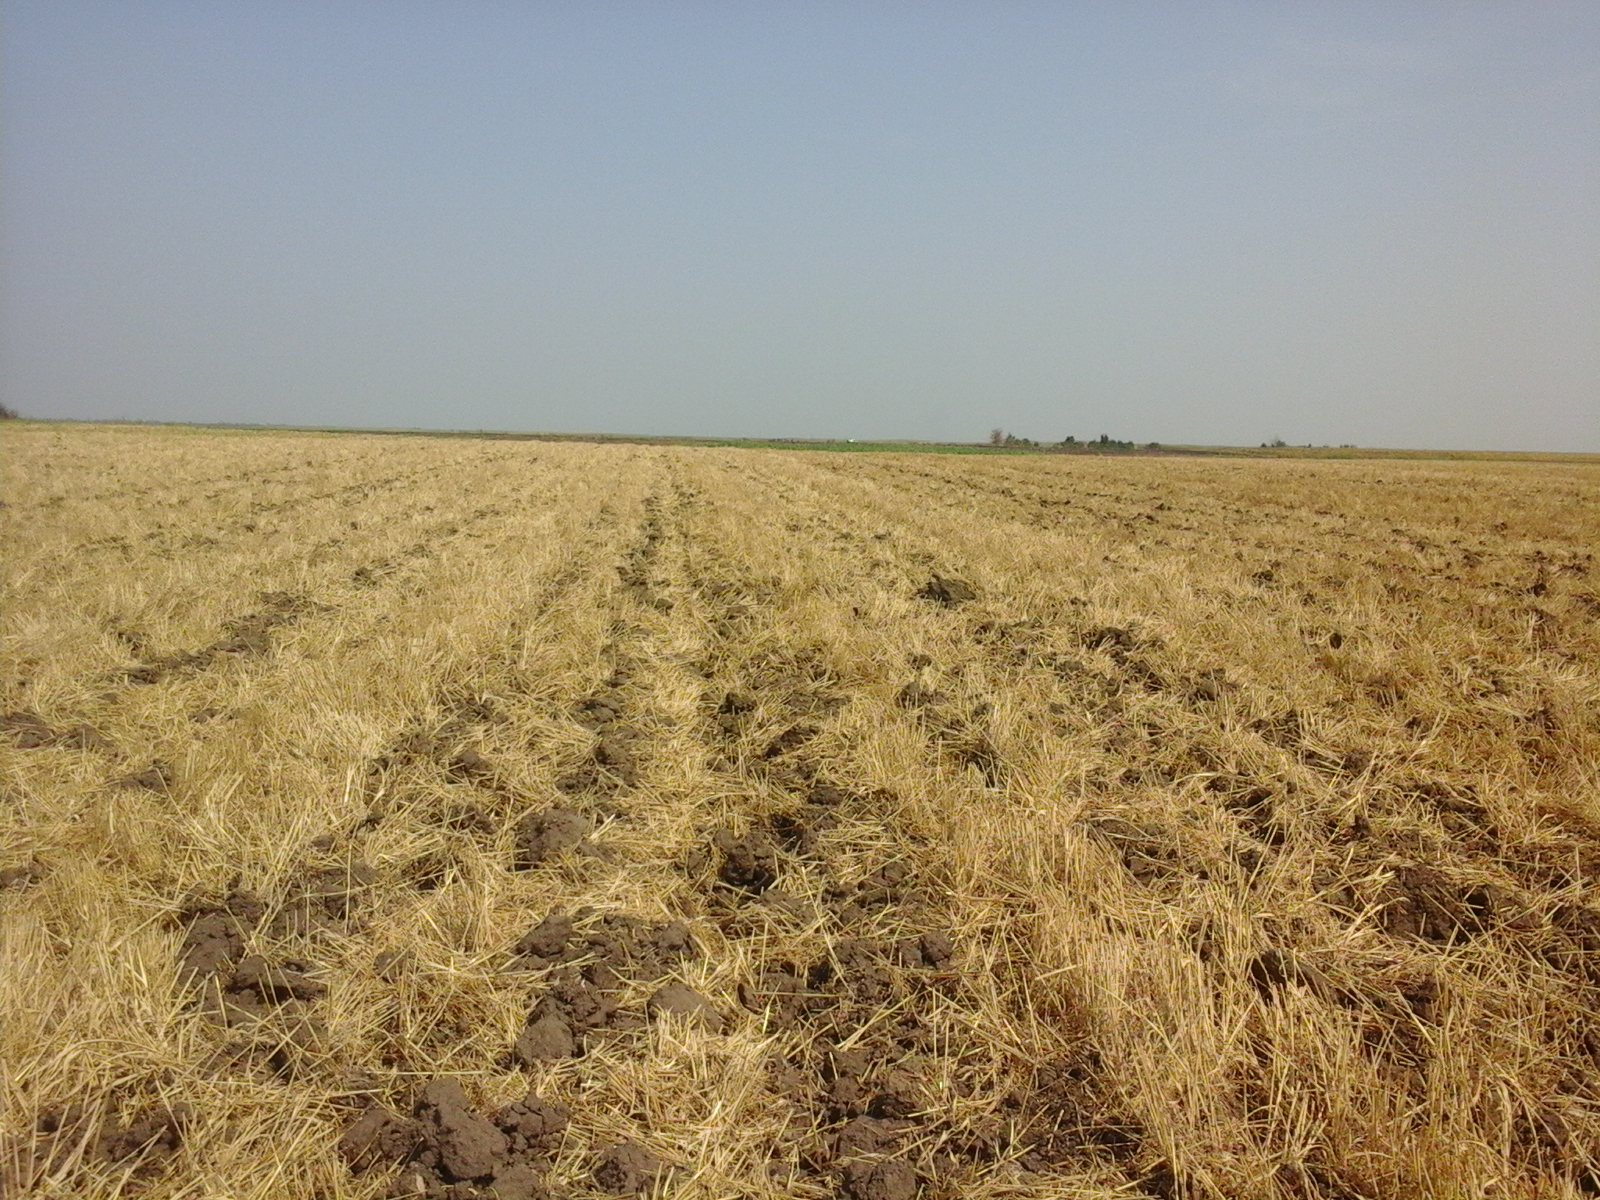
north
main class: Cropland
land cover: Common wheat
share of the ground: 50 - 75 %
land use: Agriculture (excluding fallow land and kitchen gardens)
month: August
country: RO
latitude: 43.9060
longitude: 23.3311
